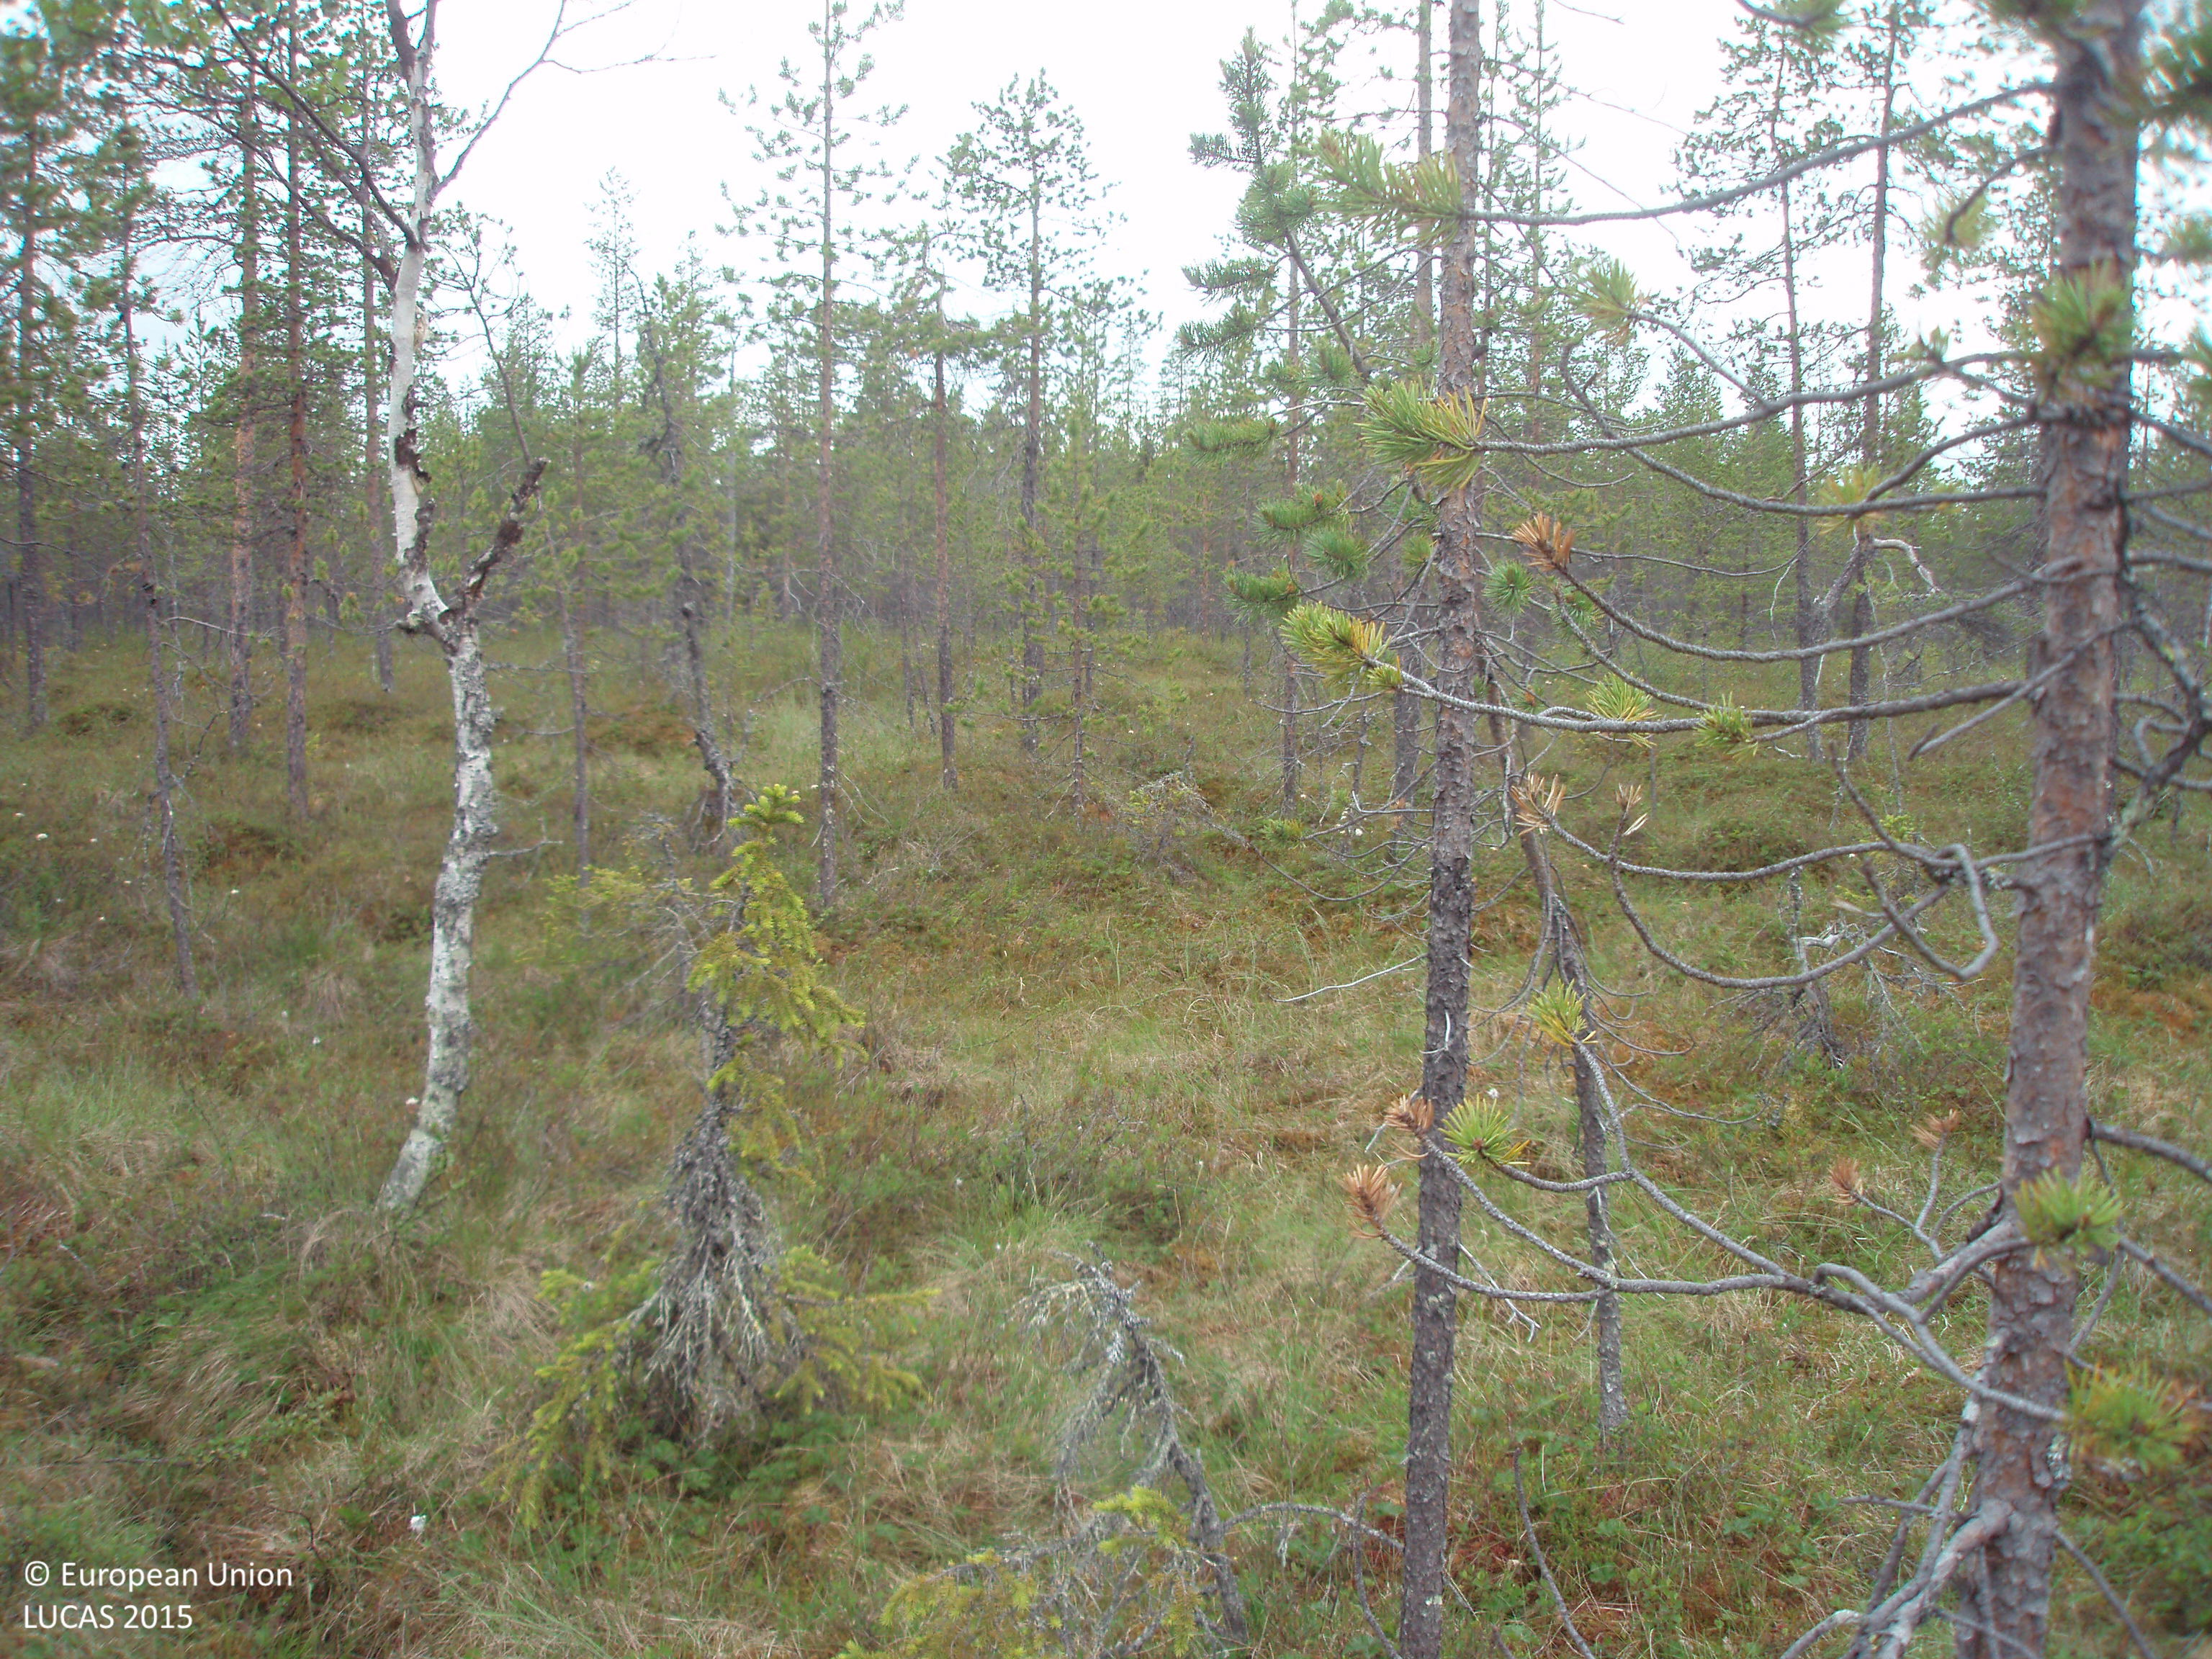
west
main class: Woodland
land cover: Pine dominated coniferous woodland
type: mire and swamp forests
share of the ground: 50 - 75 %
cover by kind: coniferous forest trees 55 %, shrubs 40 %, broadleaved forest trees 5 %
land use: Forestry
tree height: > 5 m
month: July
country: FI
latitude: 67.7548
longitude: 28.8104
